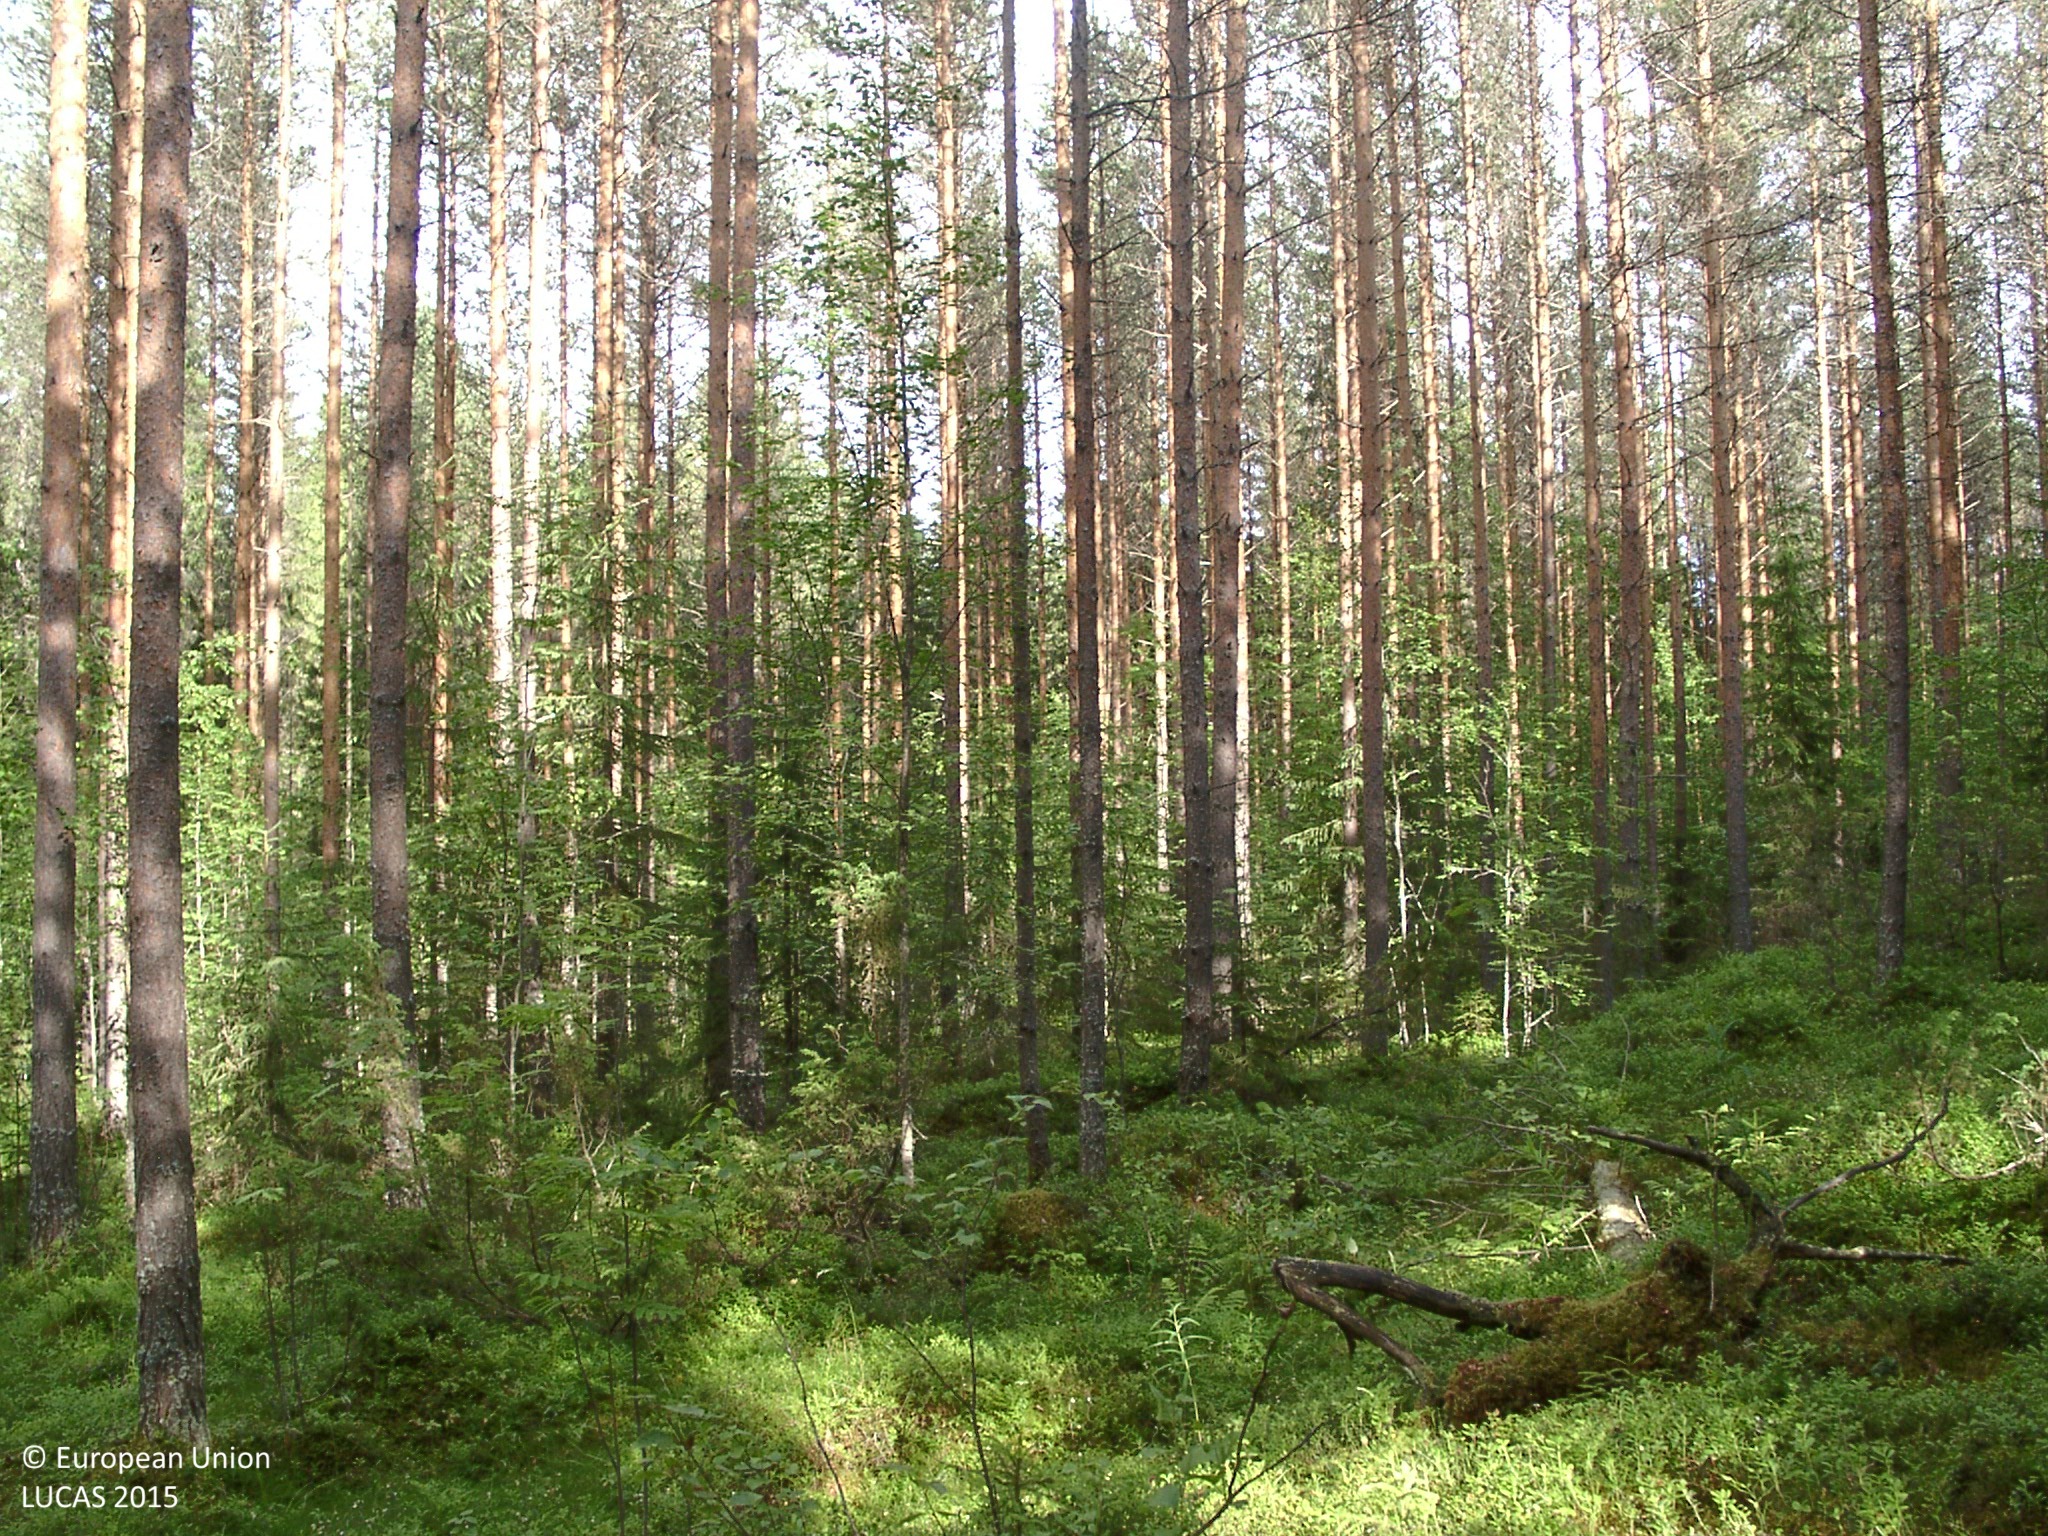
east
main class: Woodland
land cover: Other coniferous woodland
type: boreal forest
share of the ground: 50 - 75 %
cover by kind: coniferous forest trees 55 %, shrubs 25 %, broadleaved forest trees 15 %, lichens and mosses 5 %
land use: Forestry
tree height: > 5 m
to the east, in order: Shruby margins; Pine dominated mixed woodland; Spruce dominated coniferous woodland; Ditches and canals; Spruce dominated coniferous woodland; Spruce dominated mixed woodland; Grassland with sparse tree/shrub cover; Grassland without tree/shrub cover; Other fruit trees and berries; Electric lines; Managed hedges; Grass margins; Ditches and canals; Grass margins; Tracks; Grass margins; Ditches and canals; Grassland without tree/shrub cover; Broadleaved woodland; Spontaneously vegetated surfaces; Other mixed woodland
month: July
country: FI
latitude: 62.2242
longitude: 25.1679
